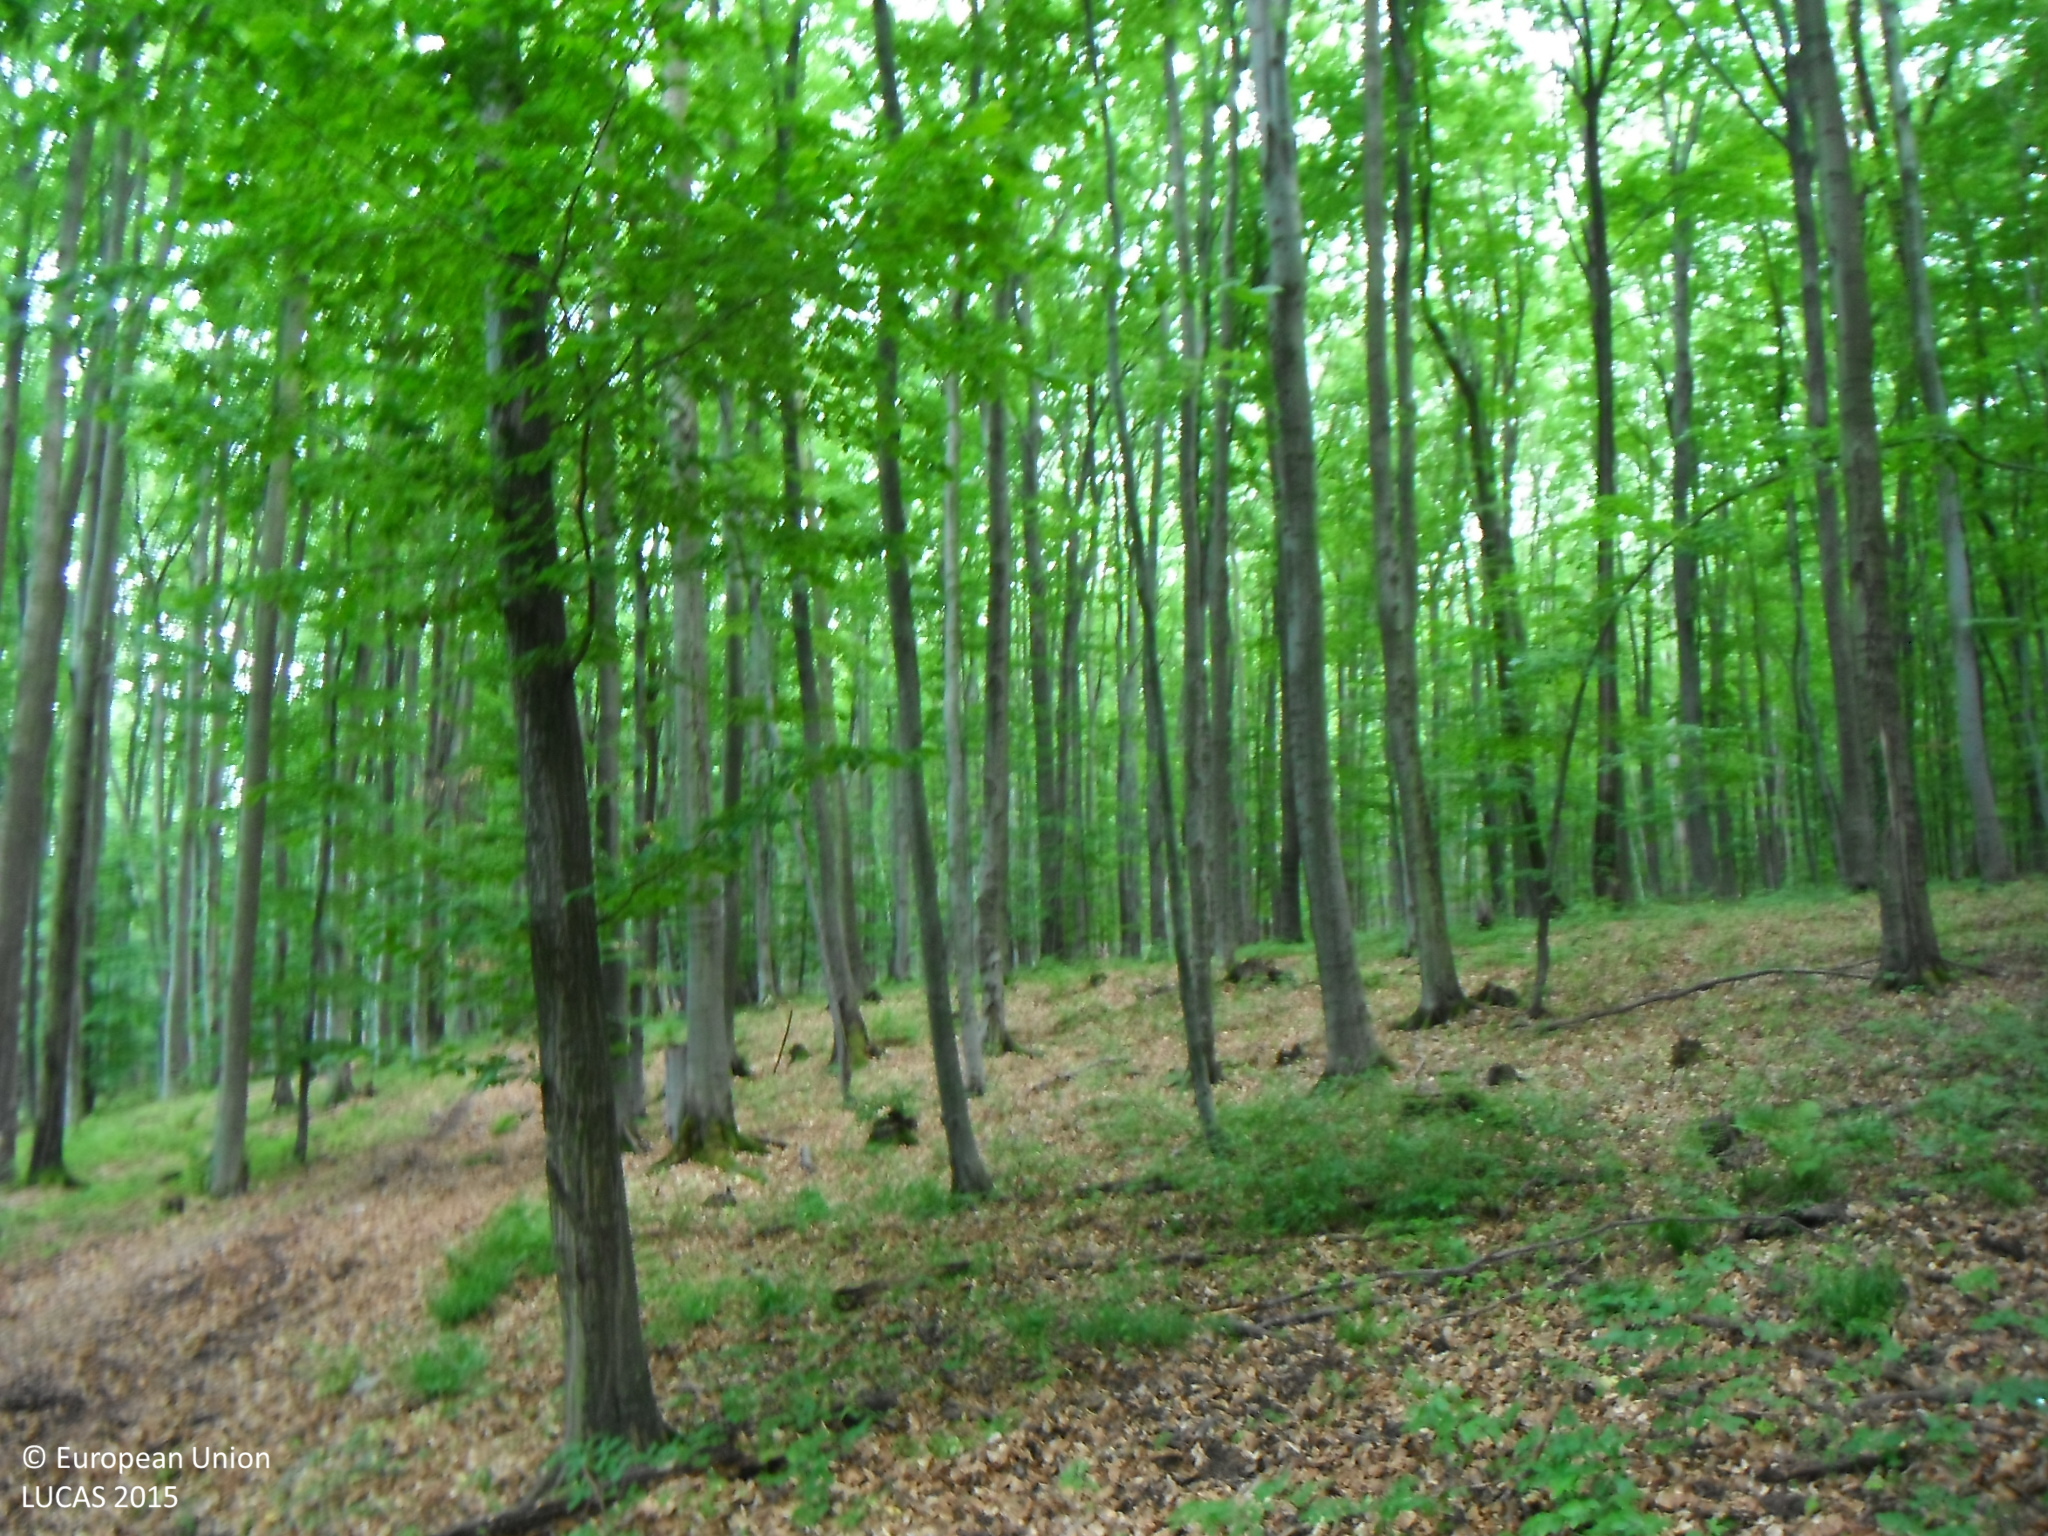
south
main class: Woodland
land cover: Broadleaved woodland
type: beech forest
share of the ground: > 75 %
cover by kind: broadleaved forest trees 100 %
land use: Forestry
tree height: > 5 m
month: June
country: SK
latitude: 49.2395
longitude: 21.2952
